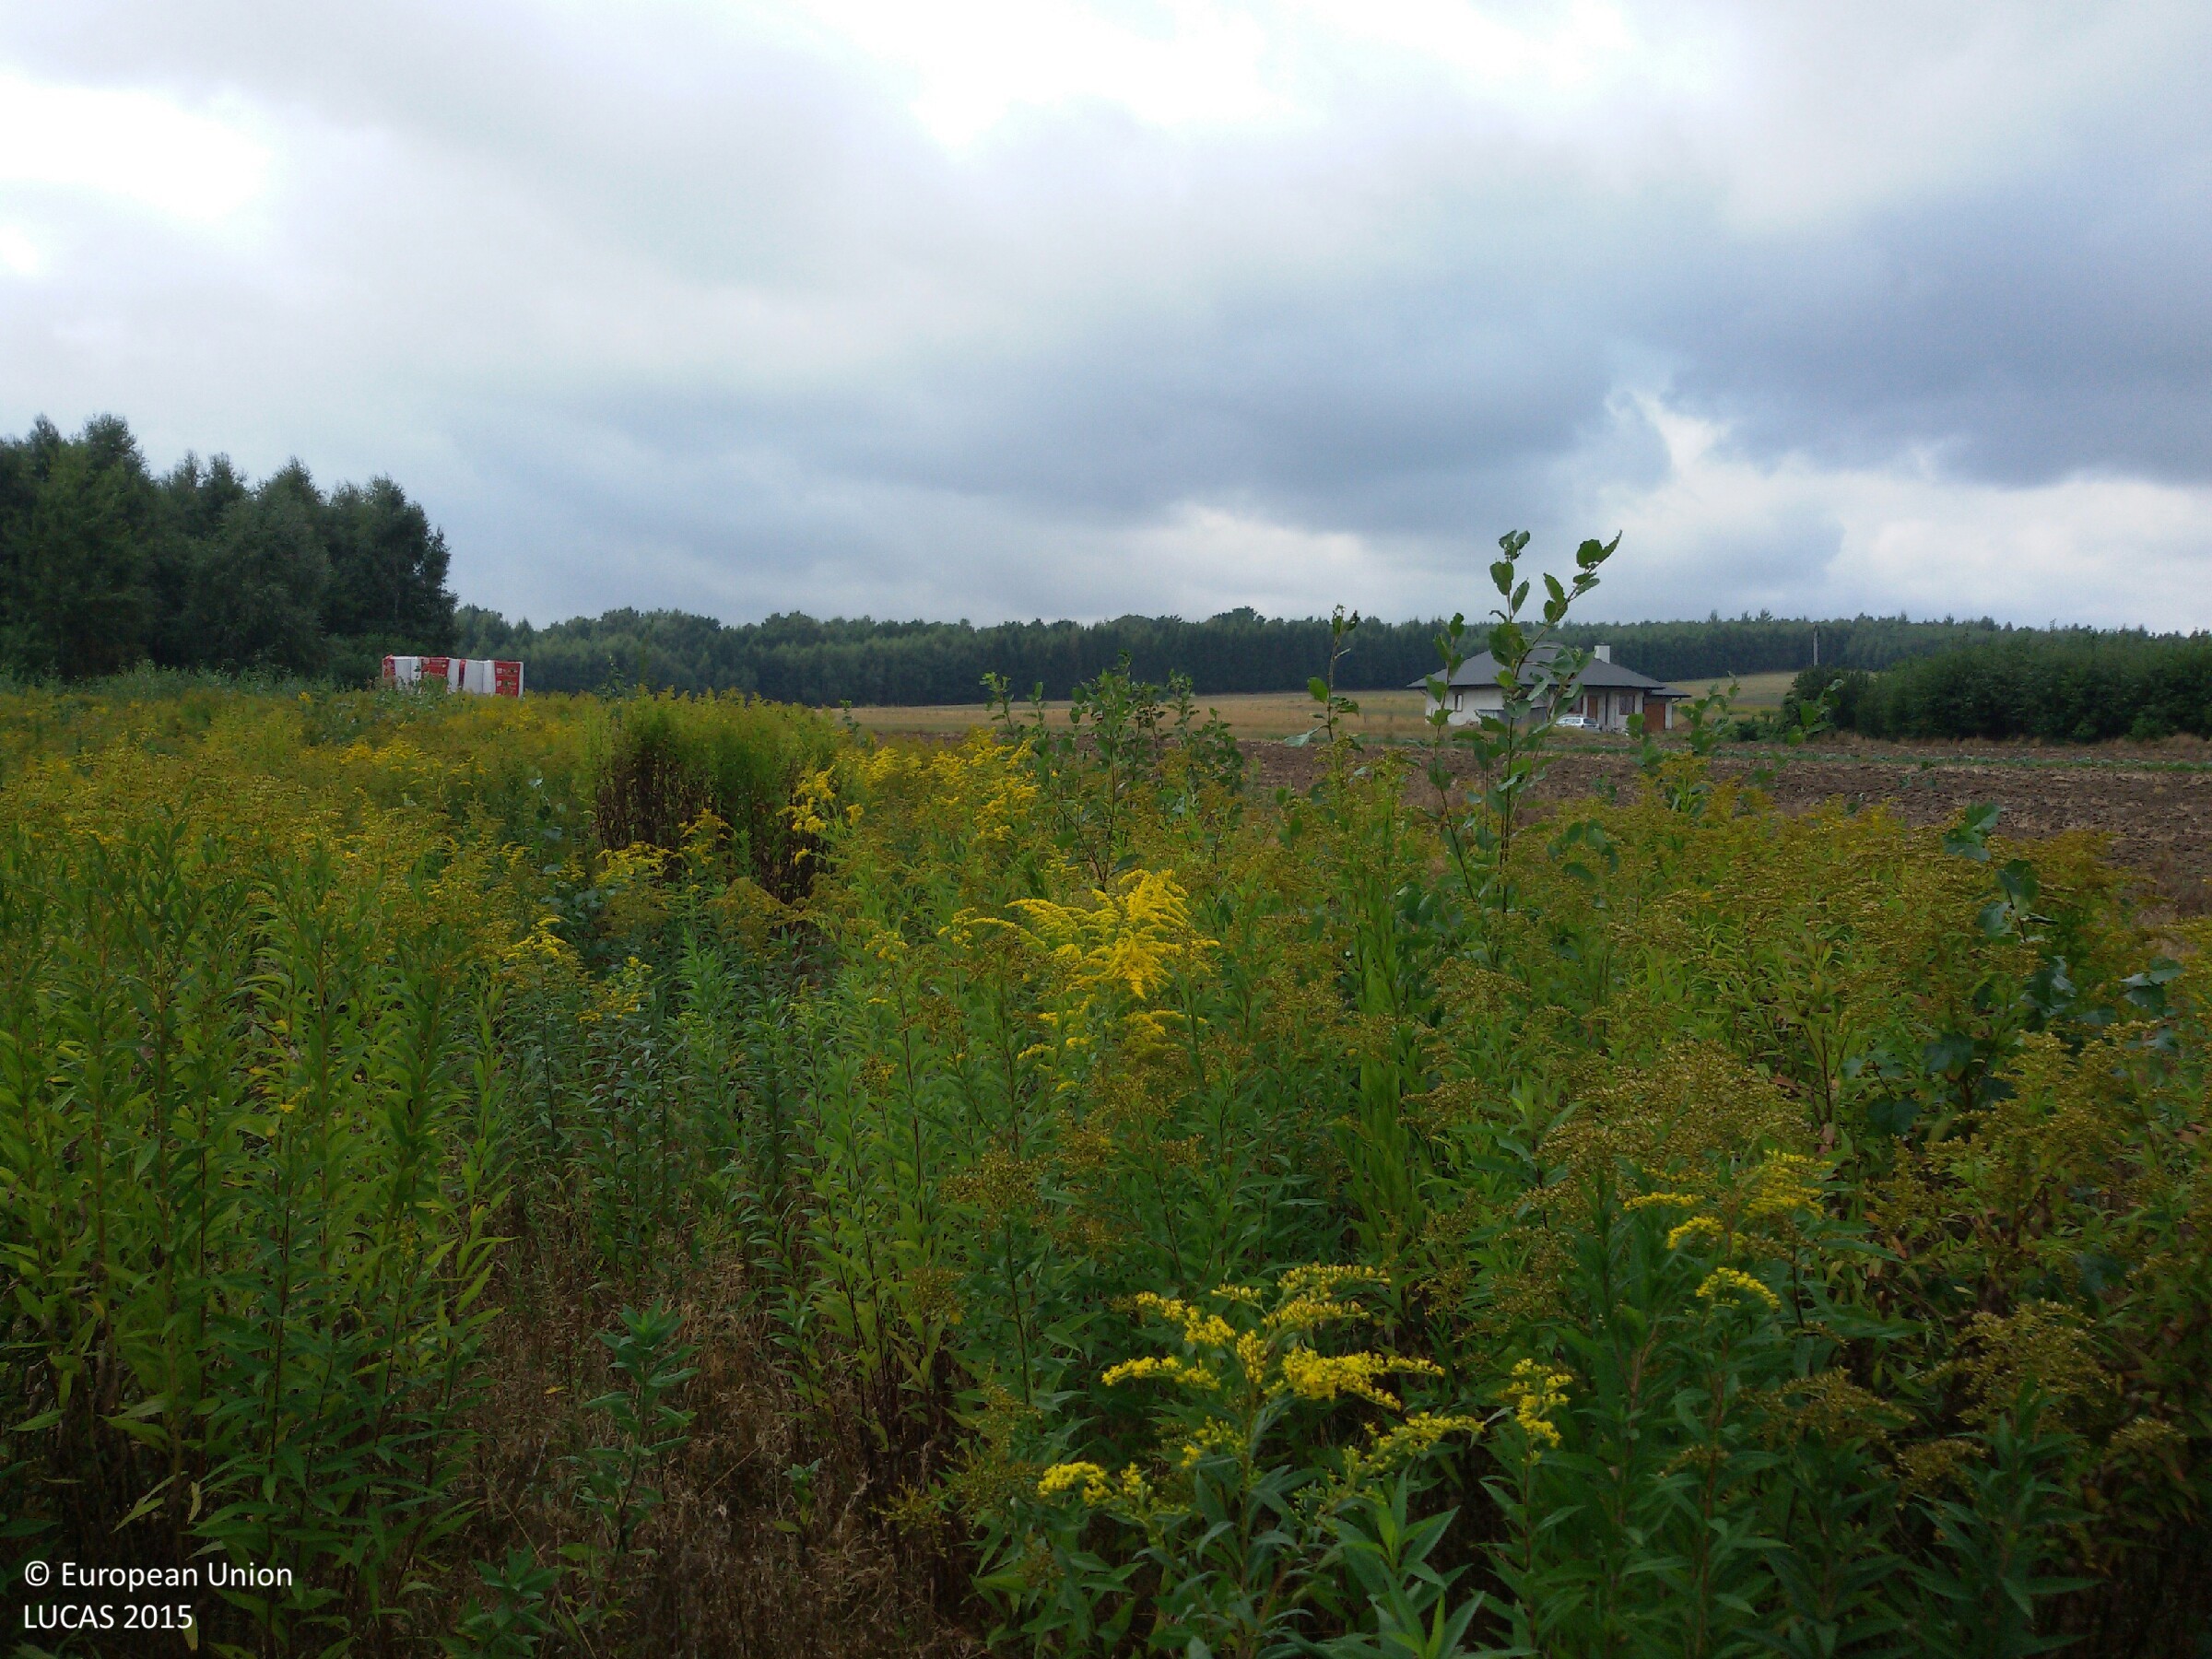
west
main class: Grassland
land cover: Spontaneously vegetated surfaces
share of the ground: > 75 %
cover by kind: herbaceous plants 100 %
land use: Fallow land
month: September
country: PL
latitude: 49.9862
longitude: 21.2745
